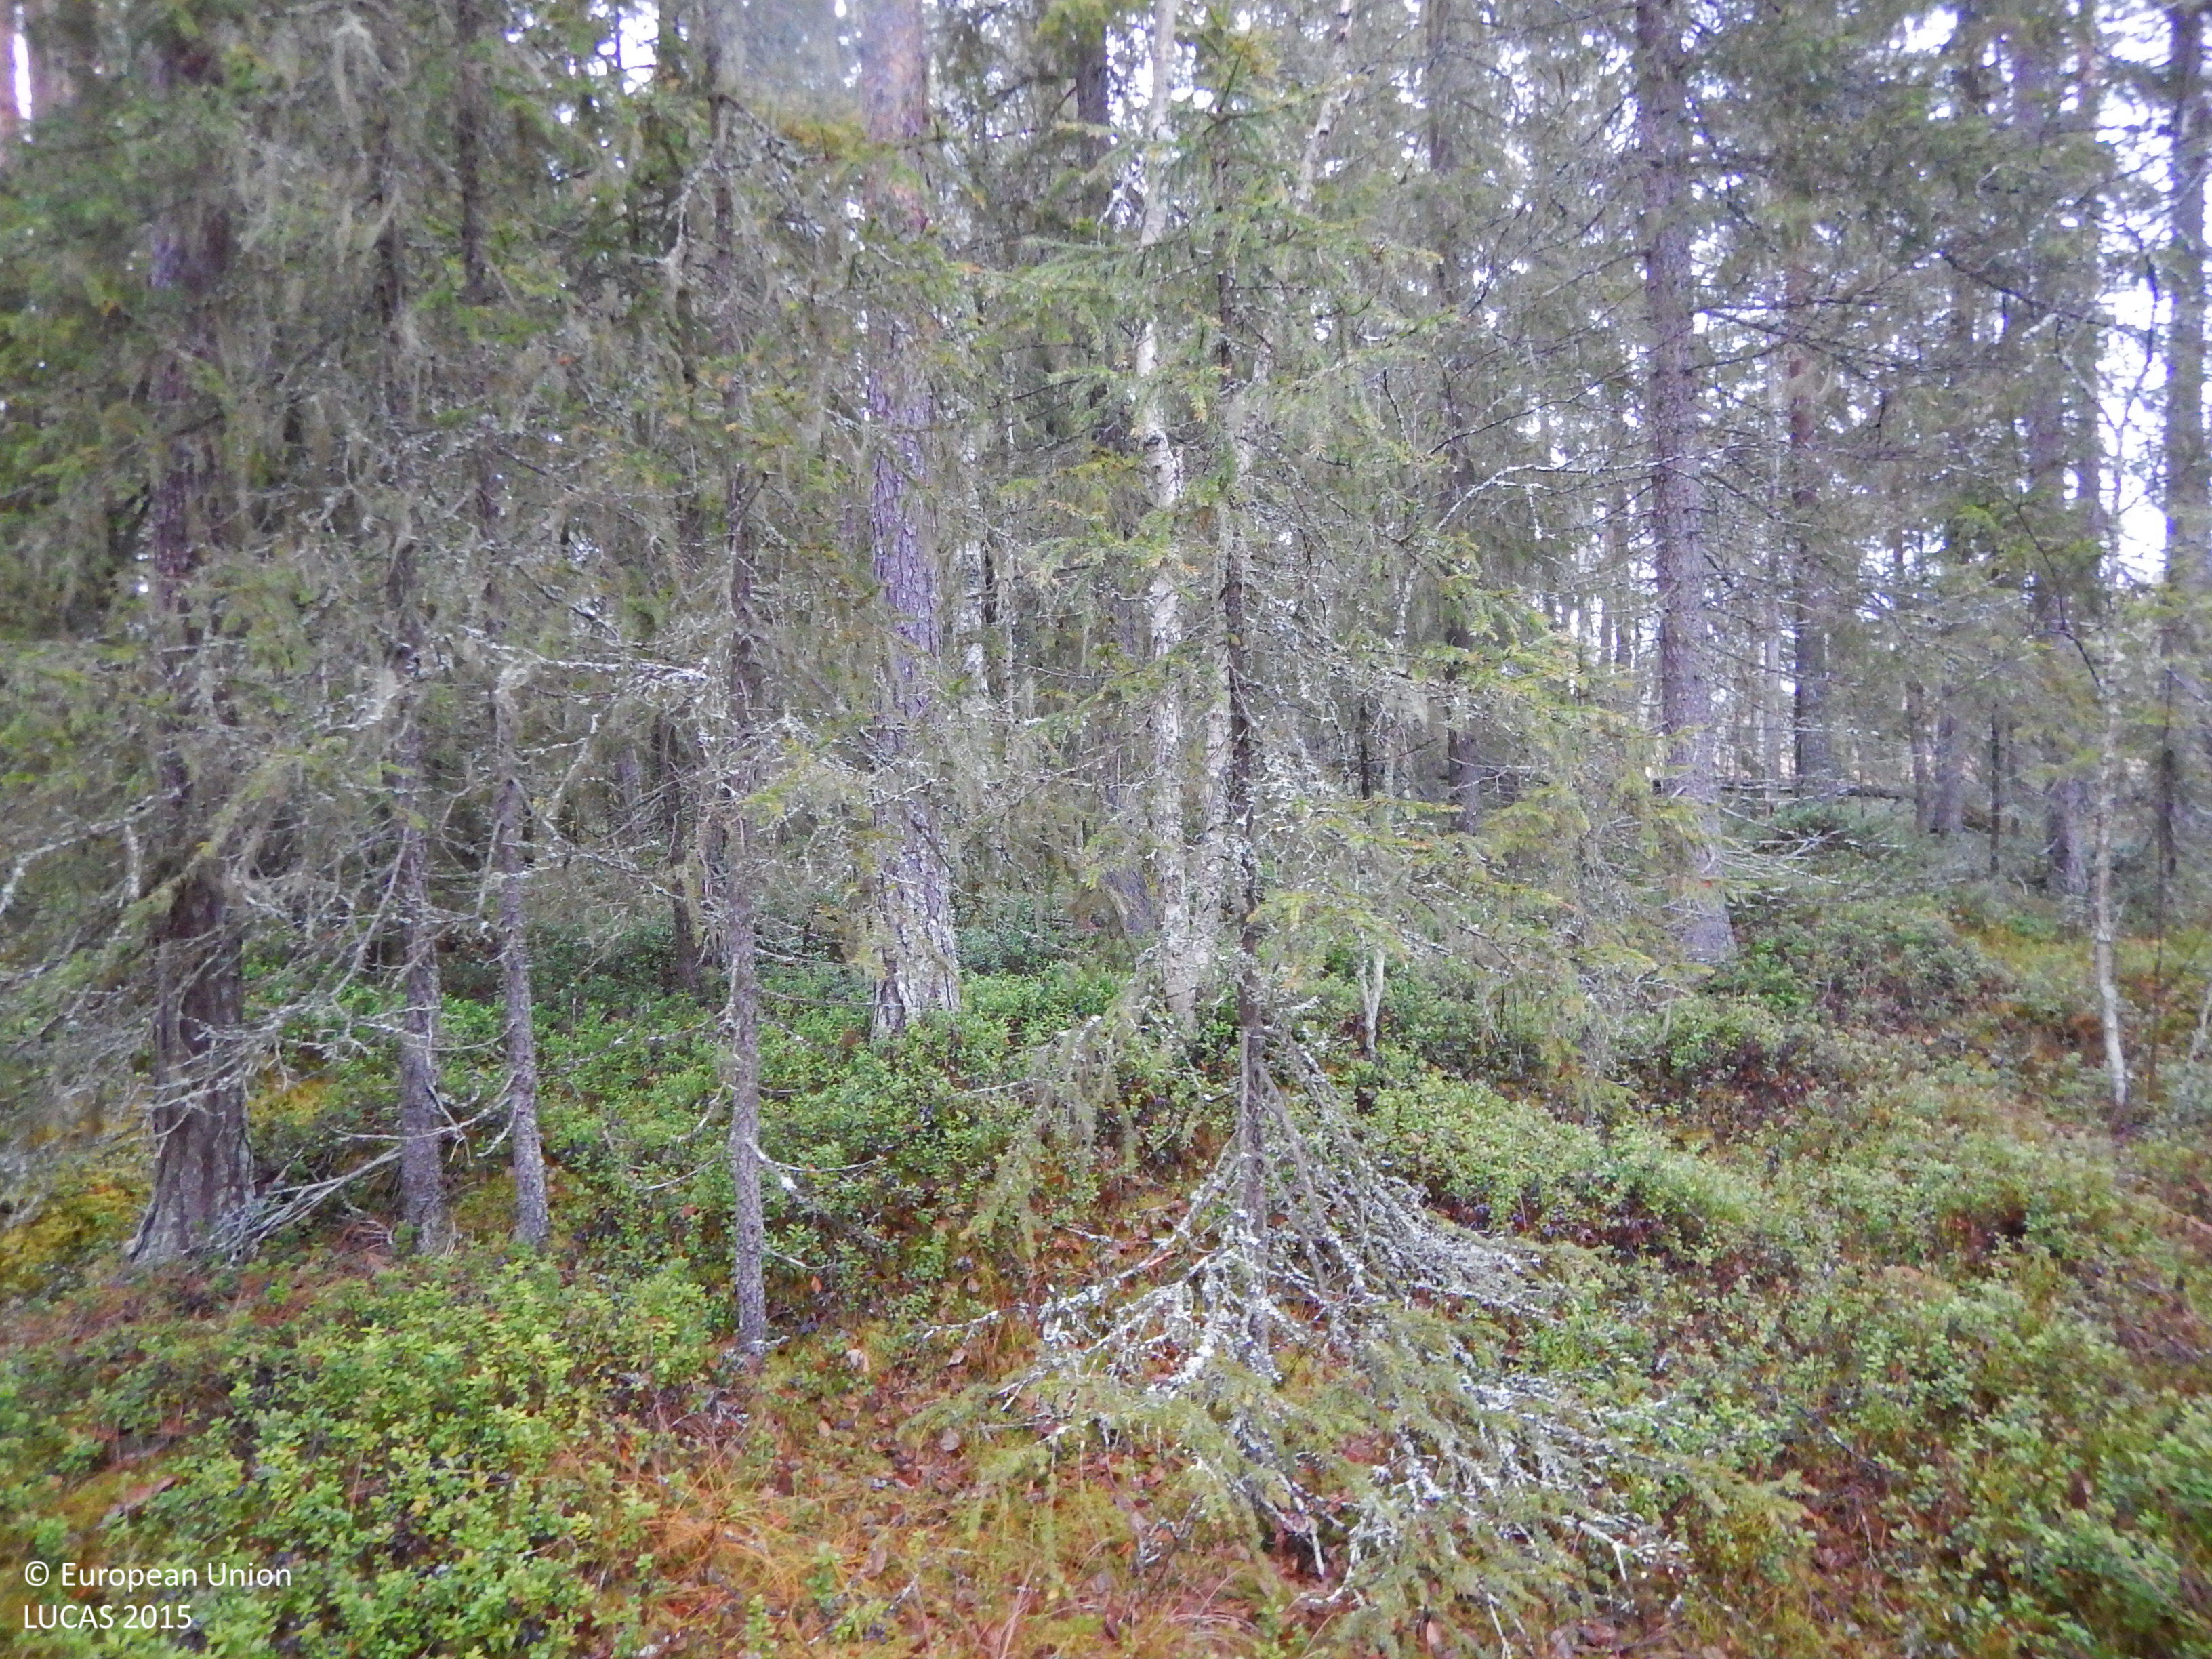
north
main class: Woodland
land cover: Other mixed woodland
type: boreal forest
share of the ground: 50 - 75 %
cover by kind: coniferous forest trees 40 %, lichens and mosses 20 %, broadleaved forest trees 15 %, shrubs 15 %, herbaceous plants 10 %
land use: Forestry
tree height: > 5 m
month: November
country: SE
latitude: 65.1073
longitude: 20.5108
